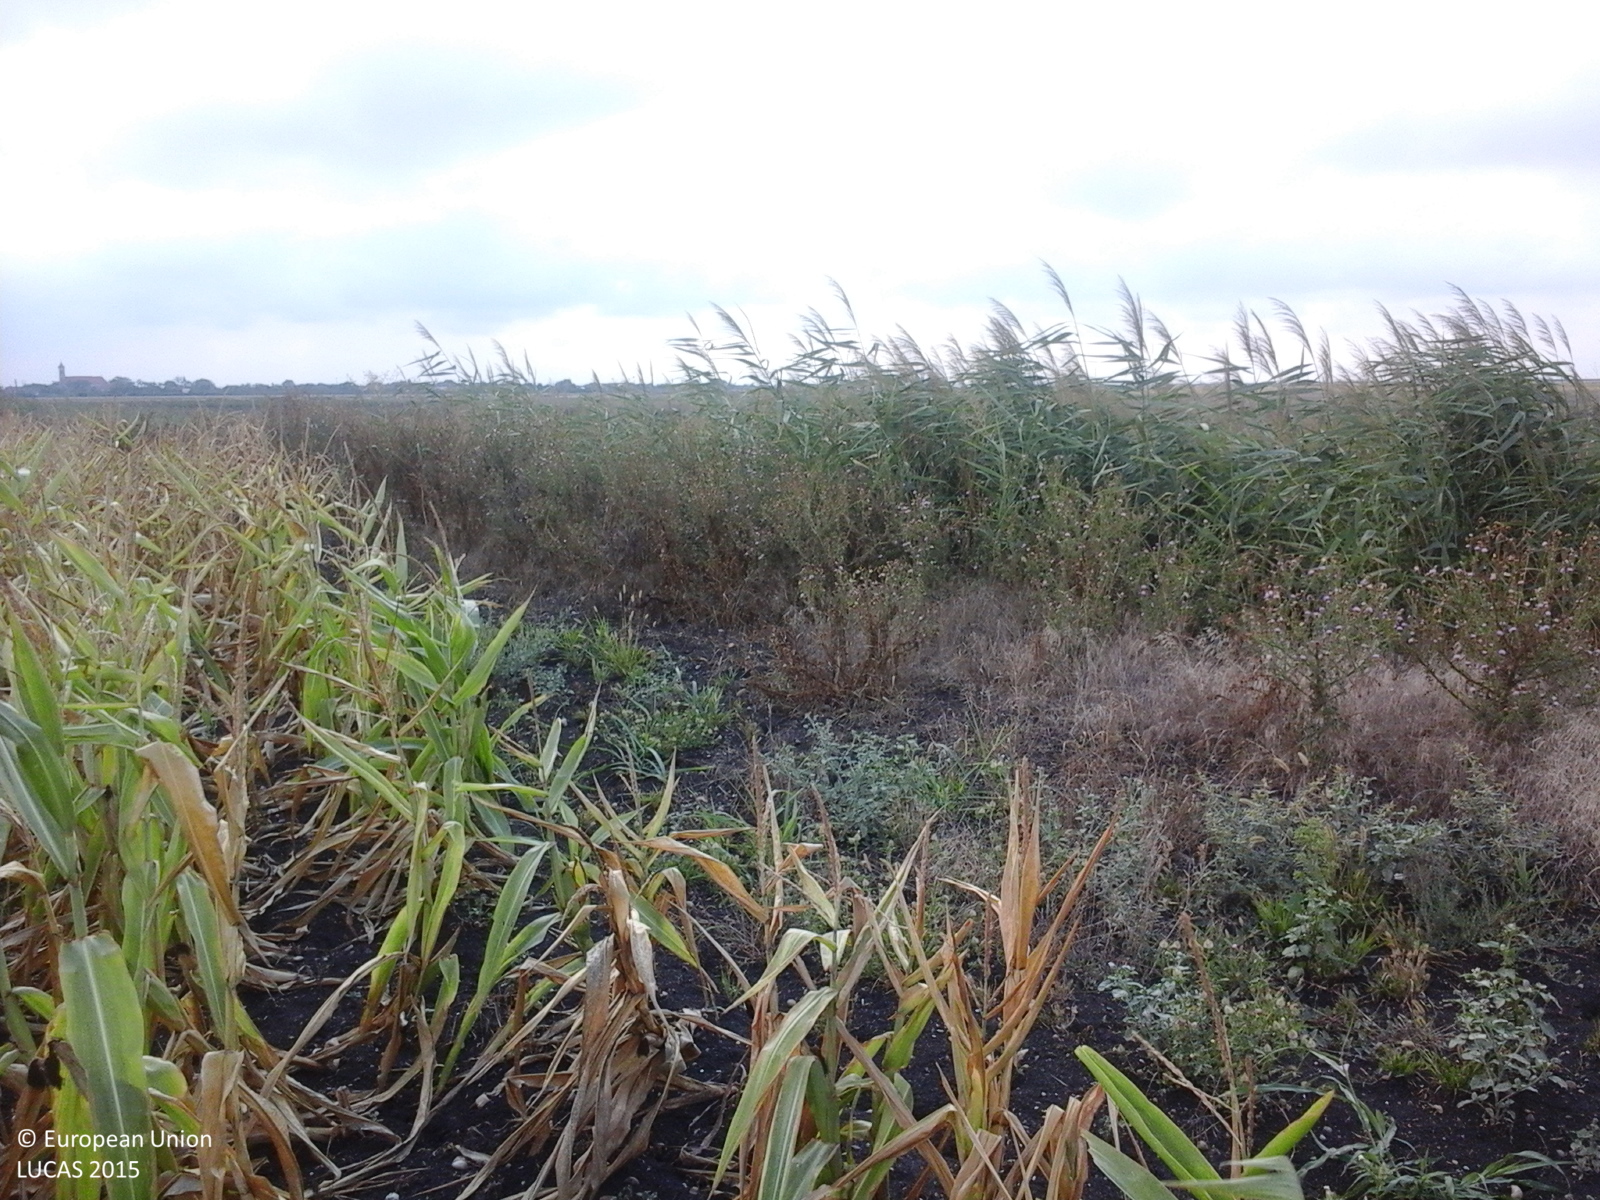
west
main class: Cropland
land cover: Maize
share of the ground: > 75 %
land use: Agriculture (excluding fallow land and kitchen gardens)
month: August
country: RO
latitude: 45.9587
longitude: 20.5141
